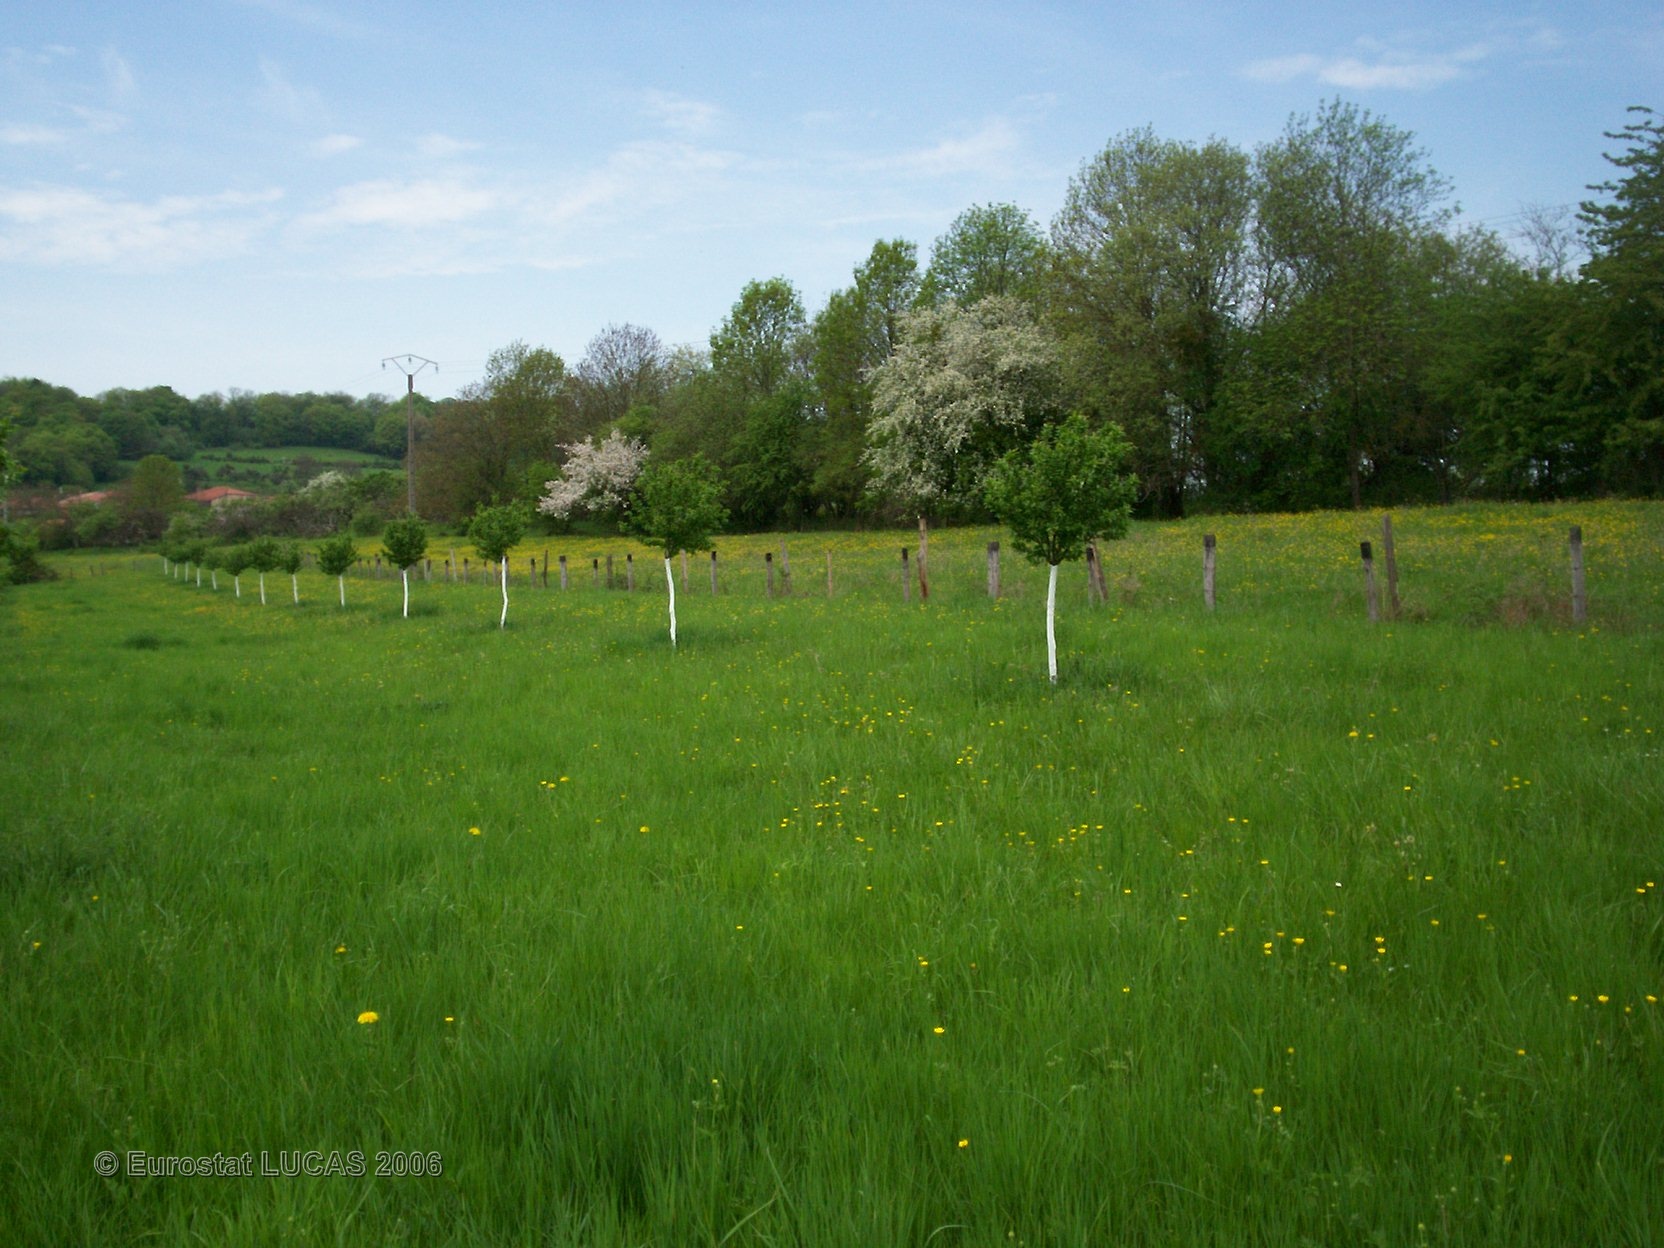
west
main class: Cropland
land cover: Other fruit trees and berries
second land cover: Grassland with sparse tree/shrub cover
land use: Agriculture (excluding fallow land and kitchen gardens)
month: May
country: FR
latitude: 48.4926
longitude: 5.9810
